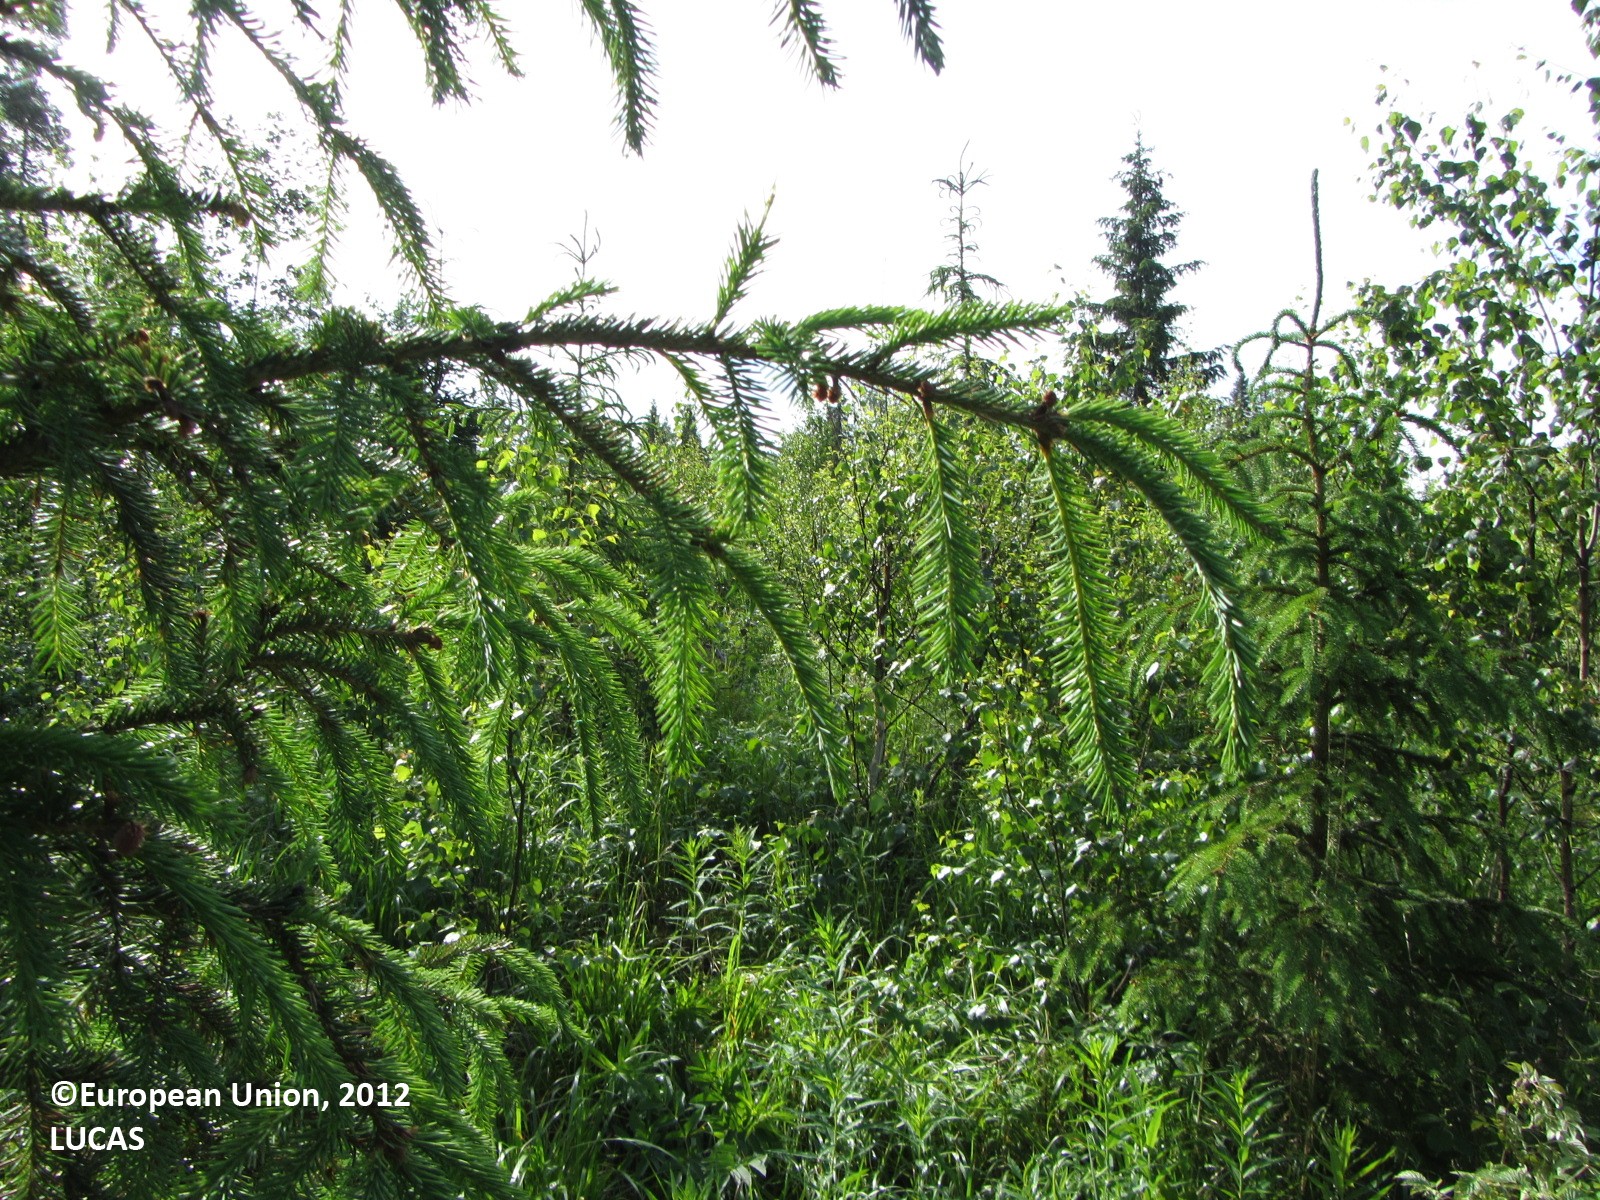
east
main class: Woodland
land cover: Broadleaved woodland
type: boreal forest
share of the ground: > 75 %
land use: Forestry
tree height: > 5 m
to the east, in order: Broadleaved woodland; Spruce dominated coniferous woodland; Tracks; Spruce dominated coniferous woodland; Spruce dominated mixed woodland; Inland marshes; Other mixed woodland; Inland marshes; Rivers and streams; Inland marshes; Other mixed woodland
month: July
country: FI
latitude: 62.9560
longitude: 25.5847
